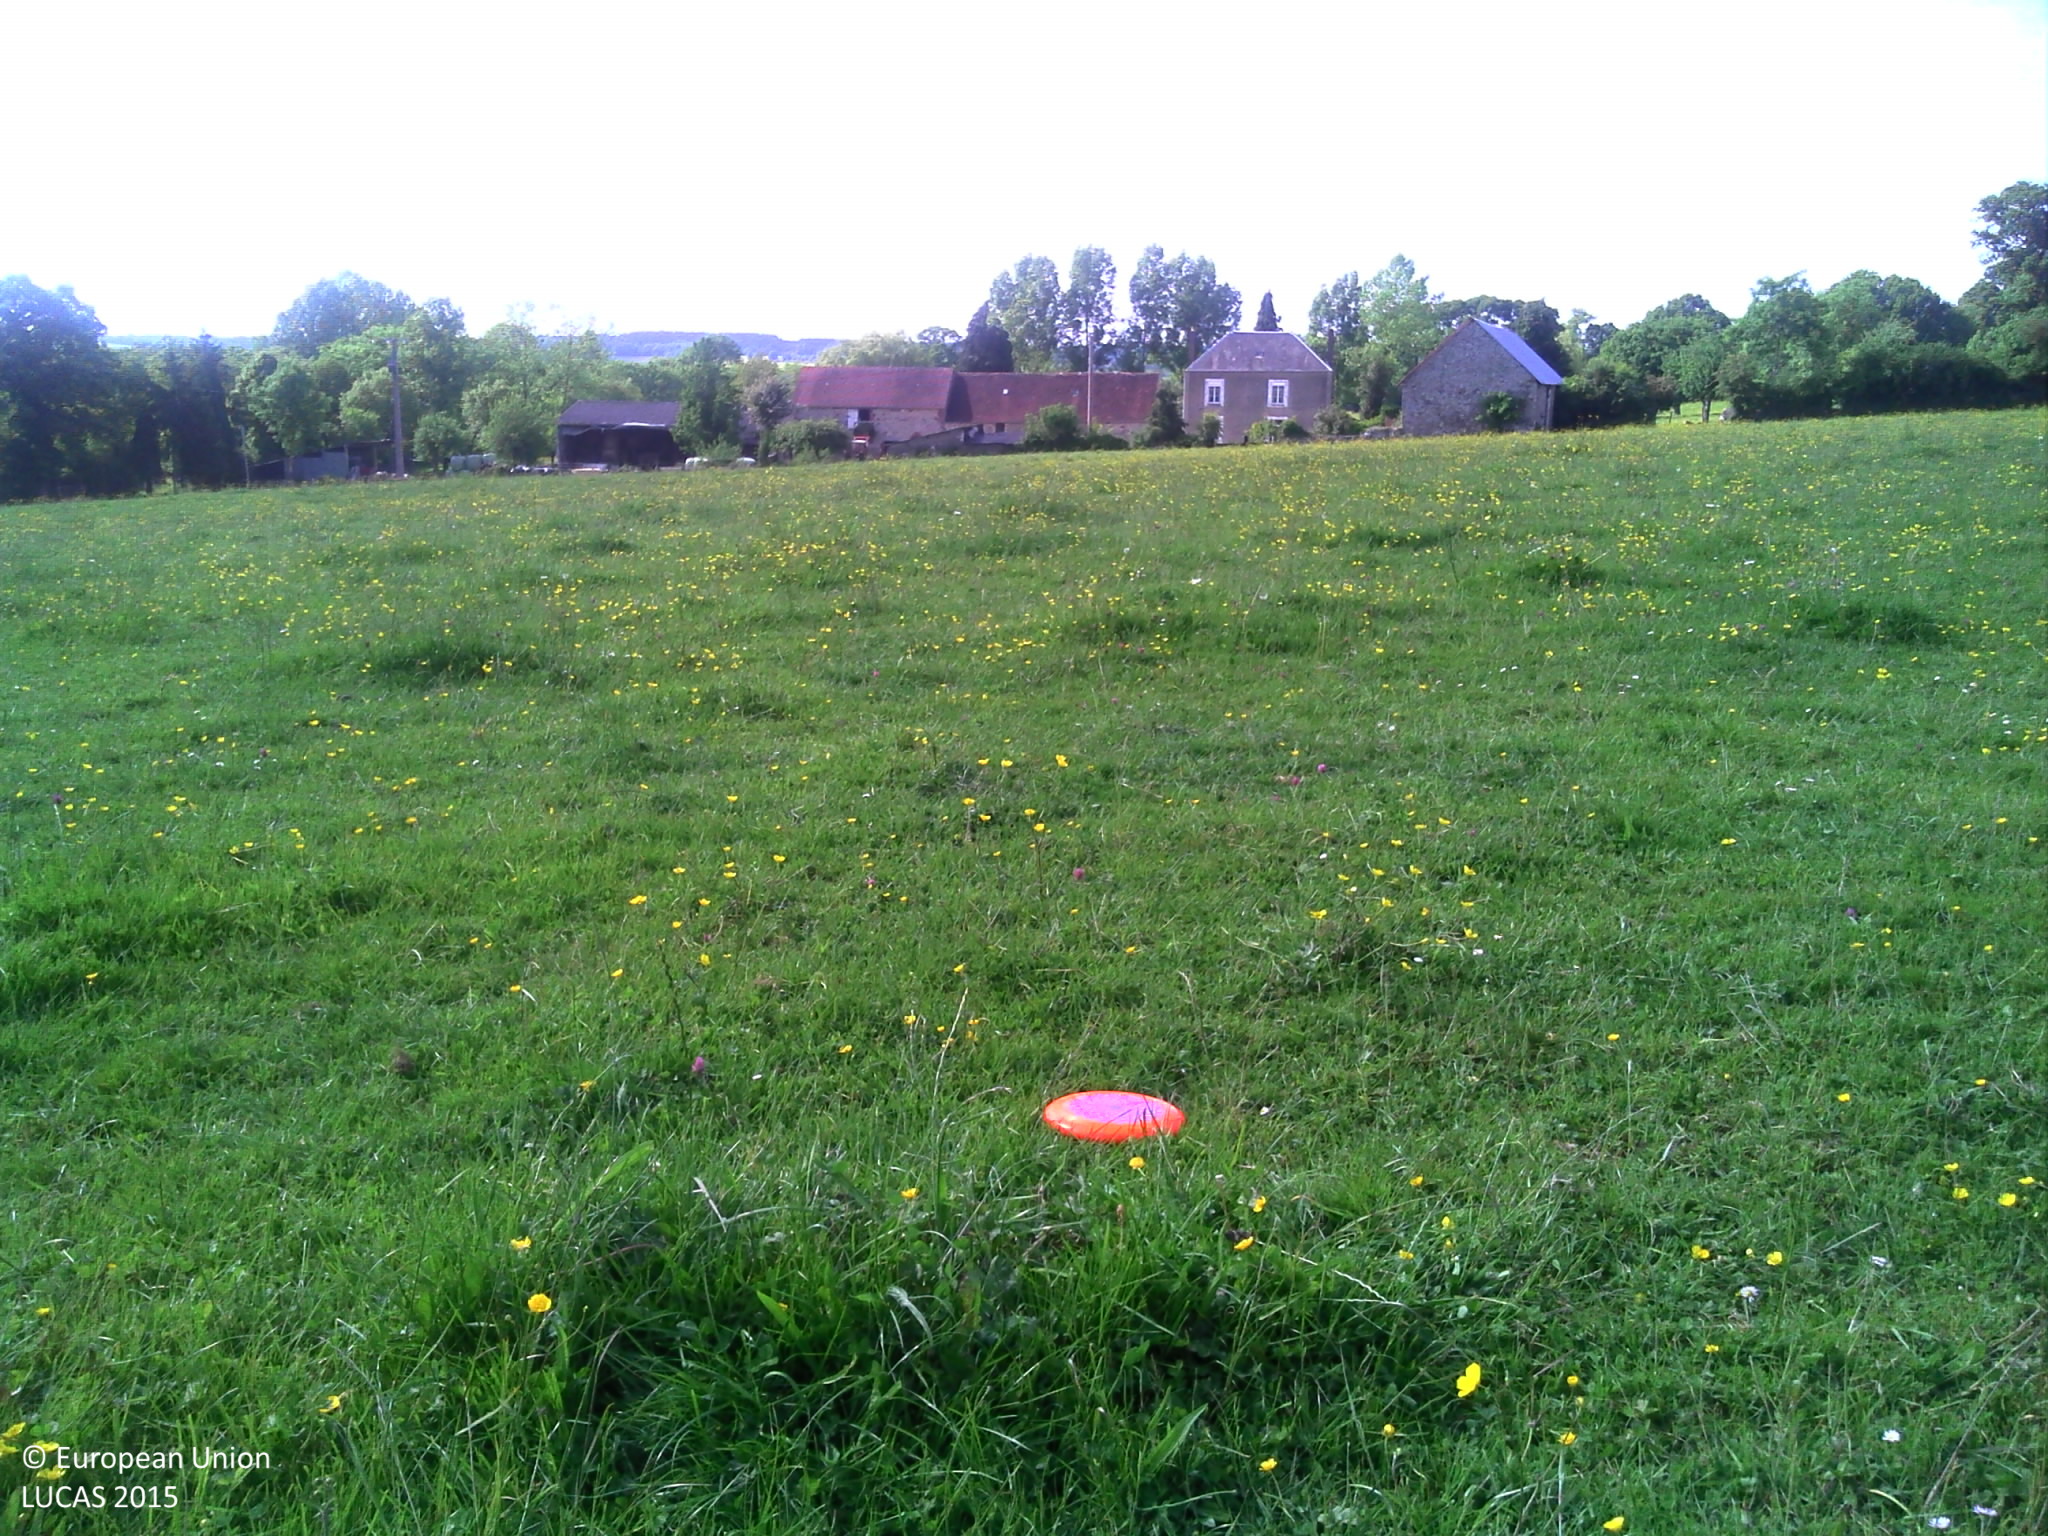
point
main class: Grassland
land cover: Grassland without tree/shrub cover
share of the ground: > 75 %
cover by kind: herbaceous plants 95 %, shrubs 5 %
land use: Agriculture (excluding fallow land and kitchen gardens)
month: May
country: FR
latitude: 48.6940
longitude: -0.1804
